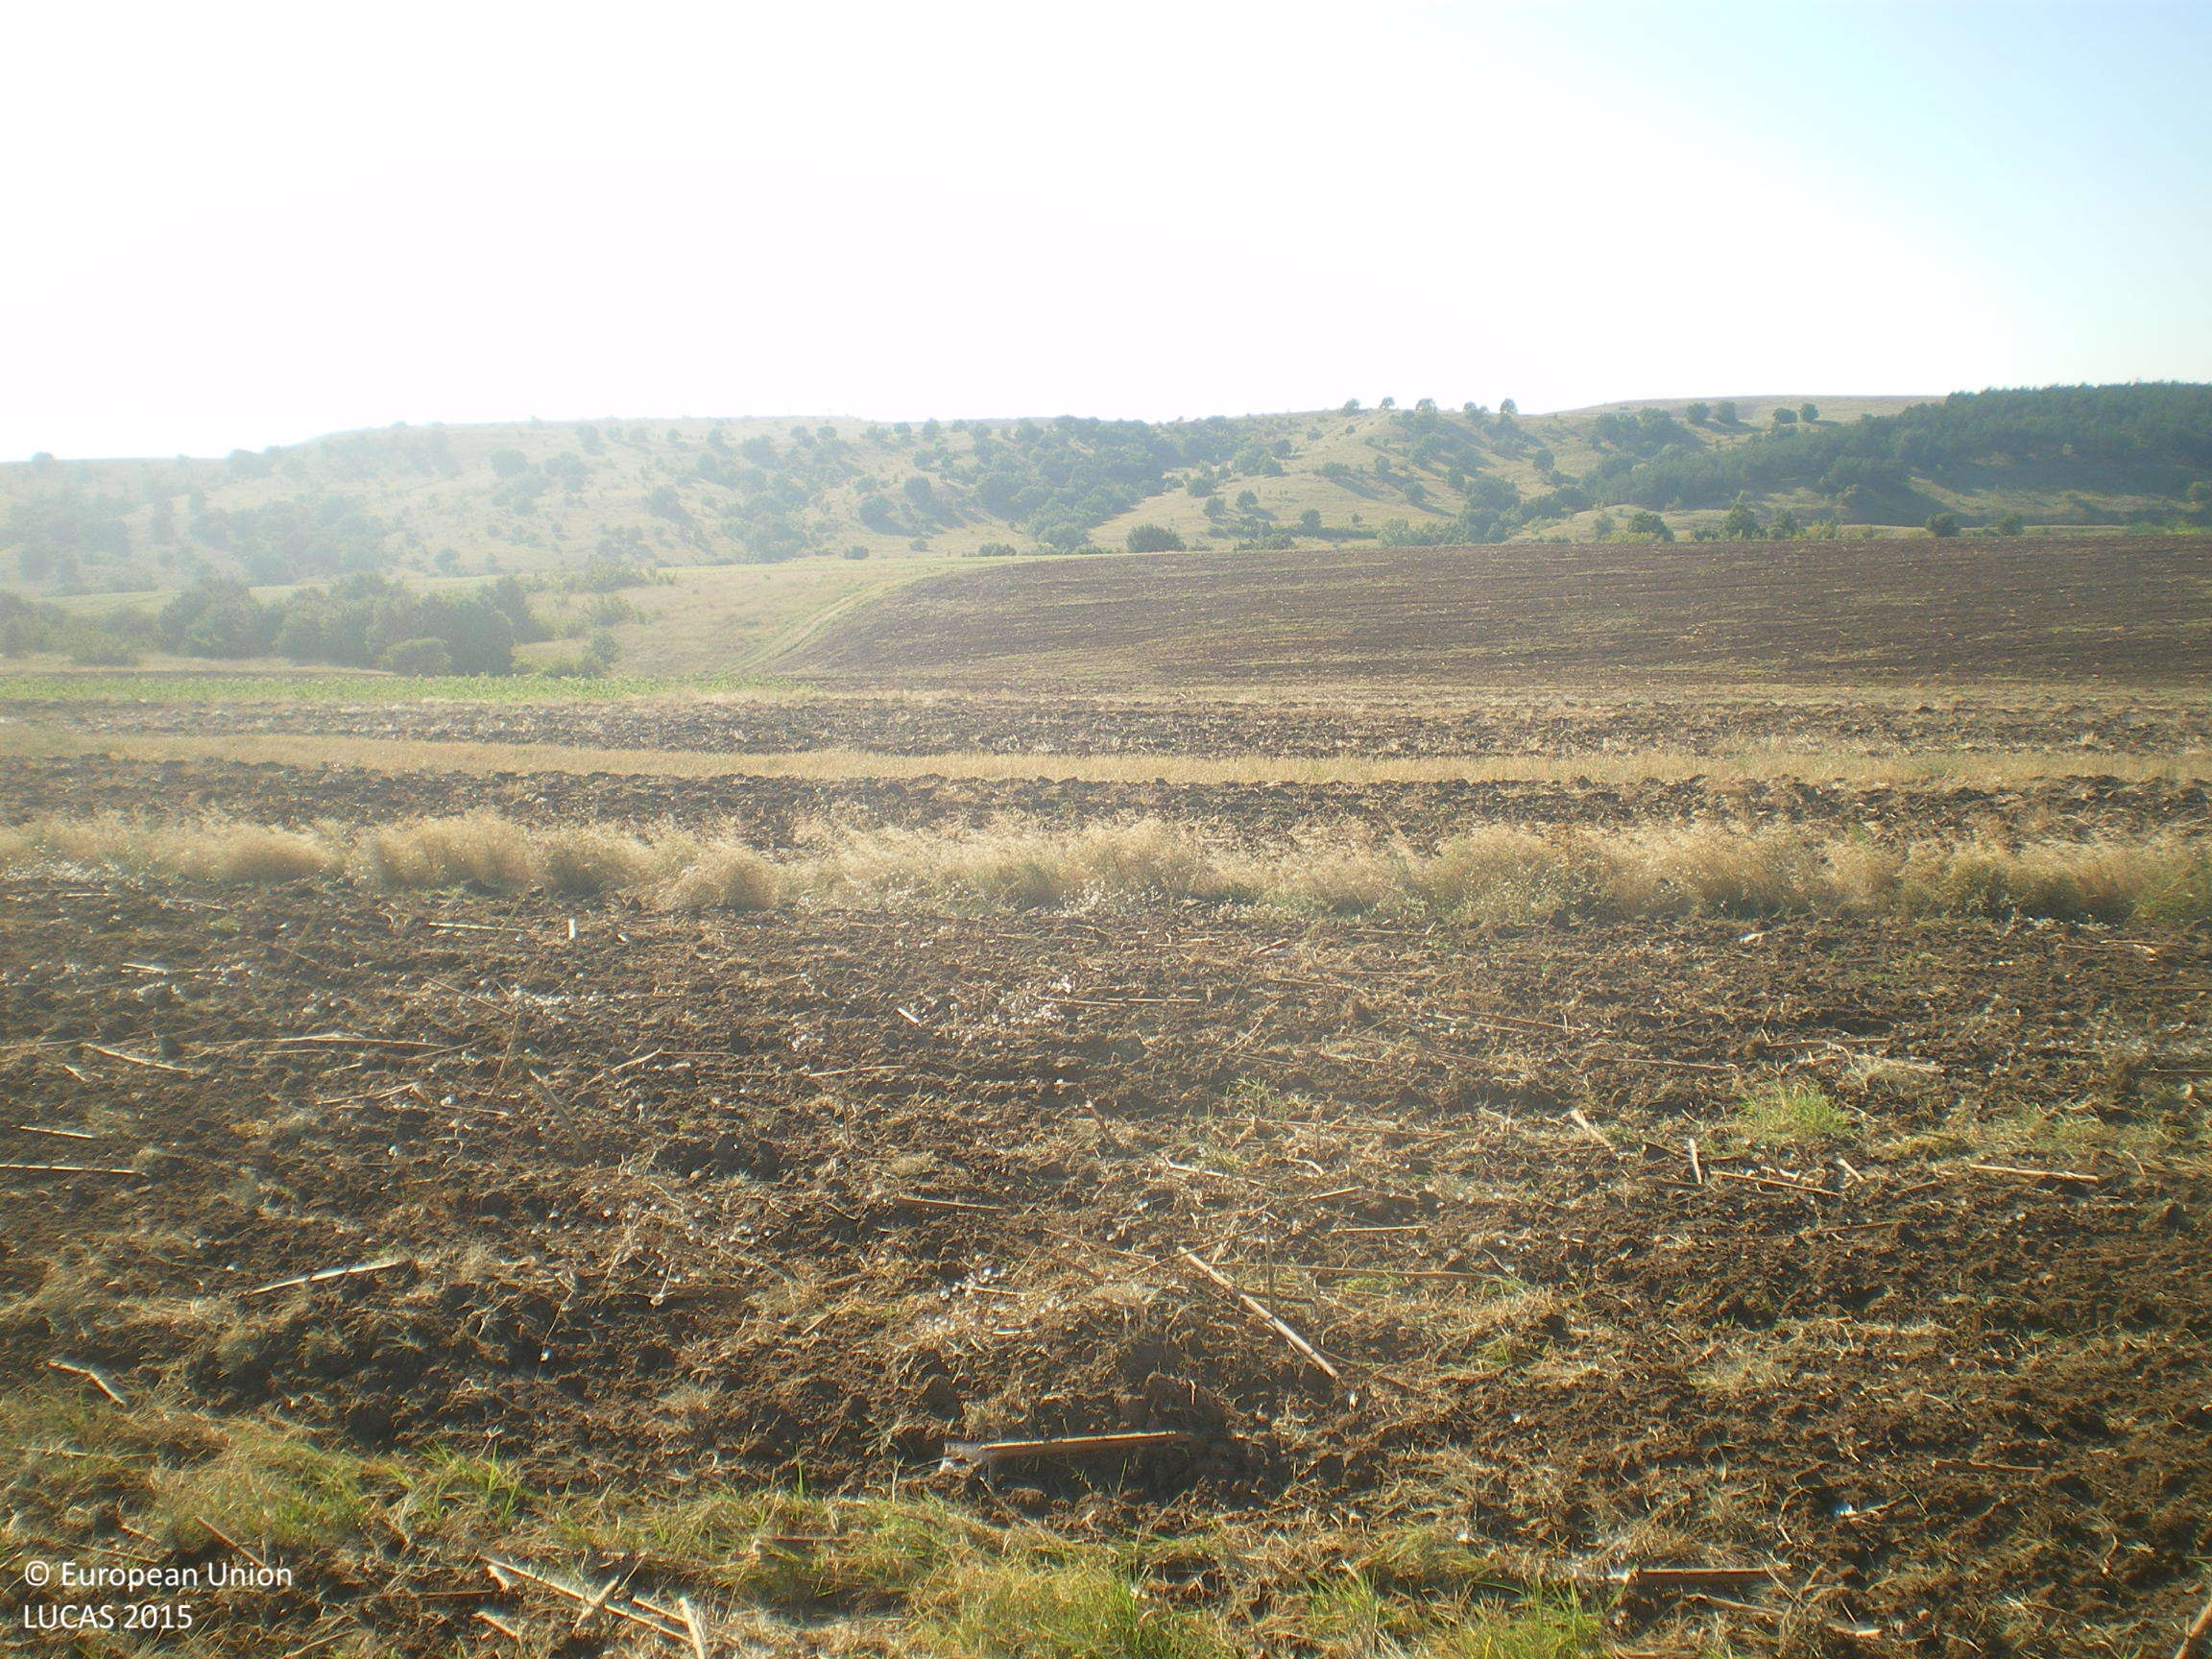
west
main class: Cropland
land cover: Sunflower
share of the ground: < 10 %
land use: Agriculture (excluding fallow land and kitchen gardens)
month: September
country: BG
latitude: 41.8205
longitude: 26.2951
